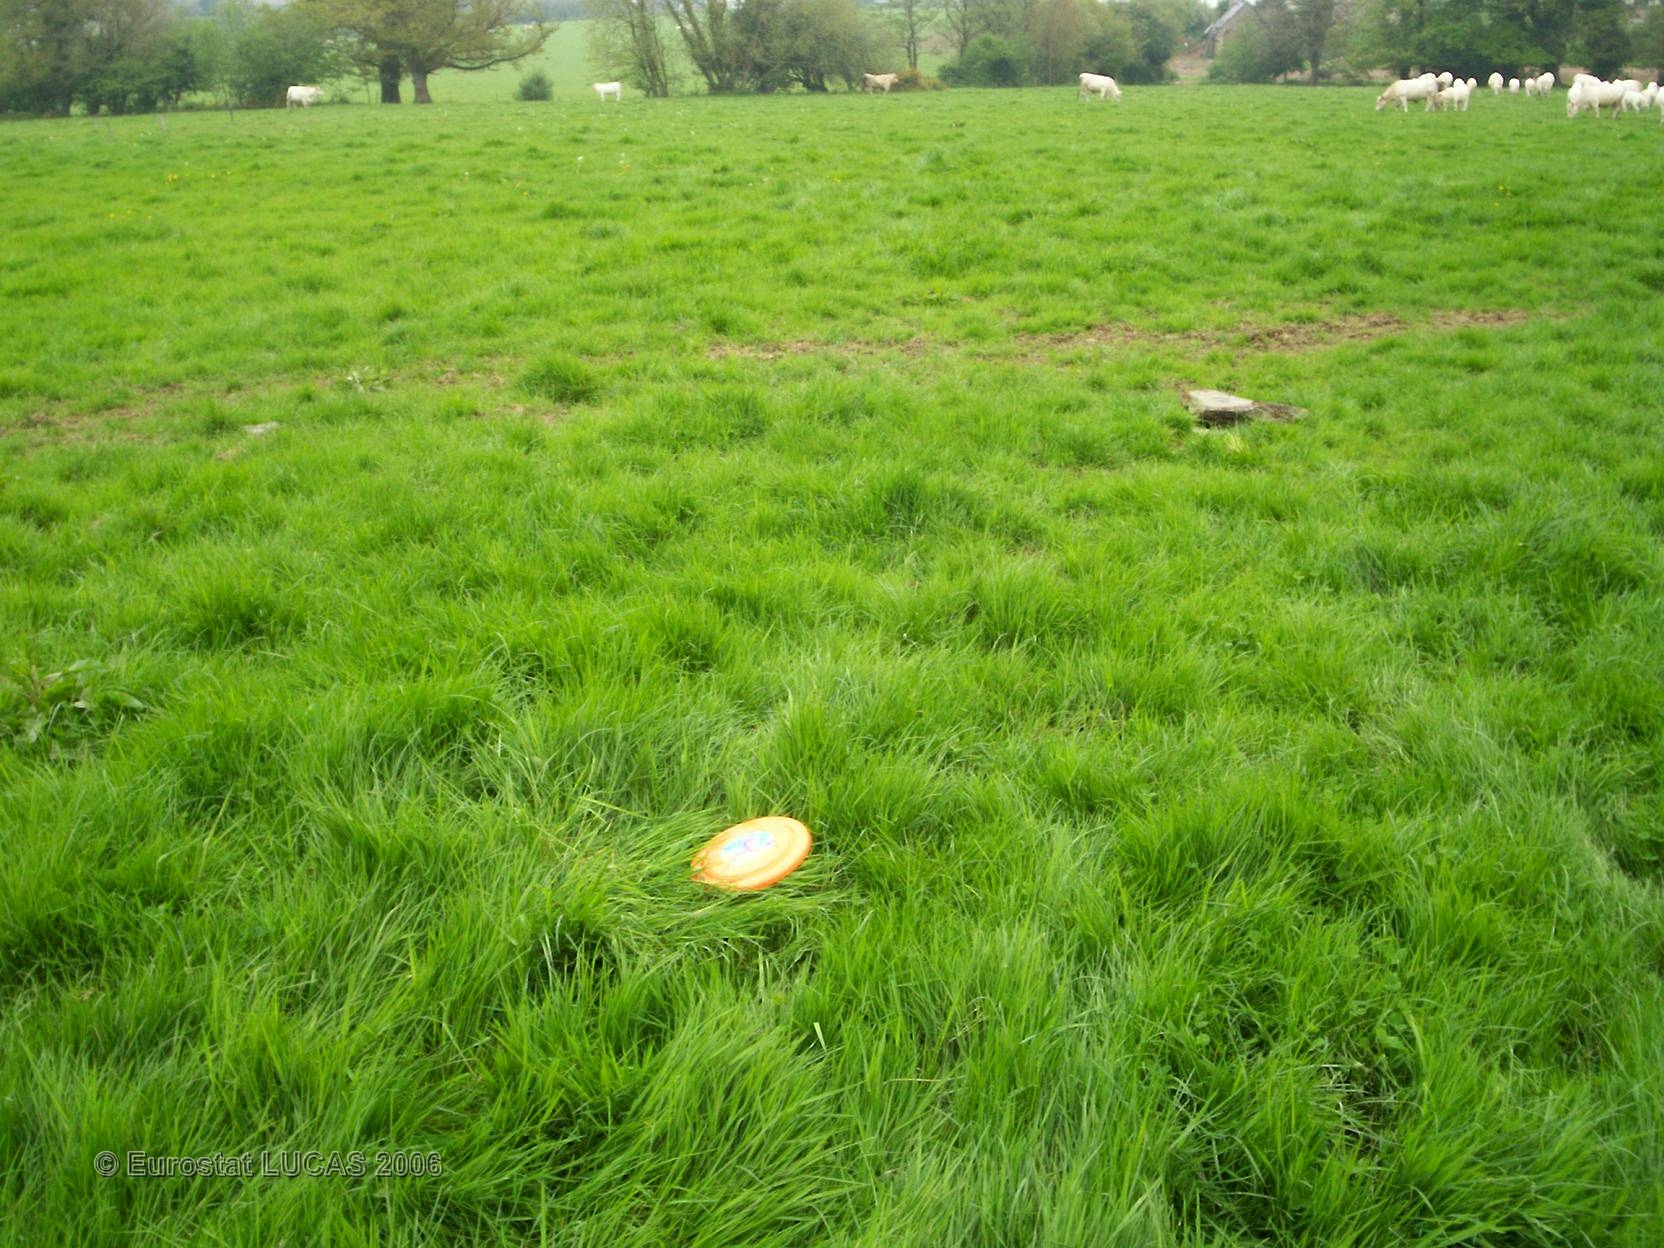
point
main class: Grassland
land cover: Grassland without tree/shrub cover
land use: Agriculture (excluding fallow land and kitchen gardens)
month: May
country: FR
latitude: 48.2004
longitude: -2.9712
